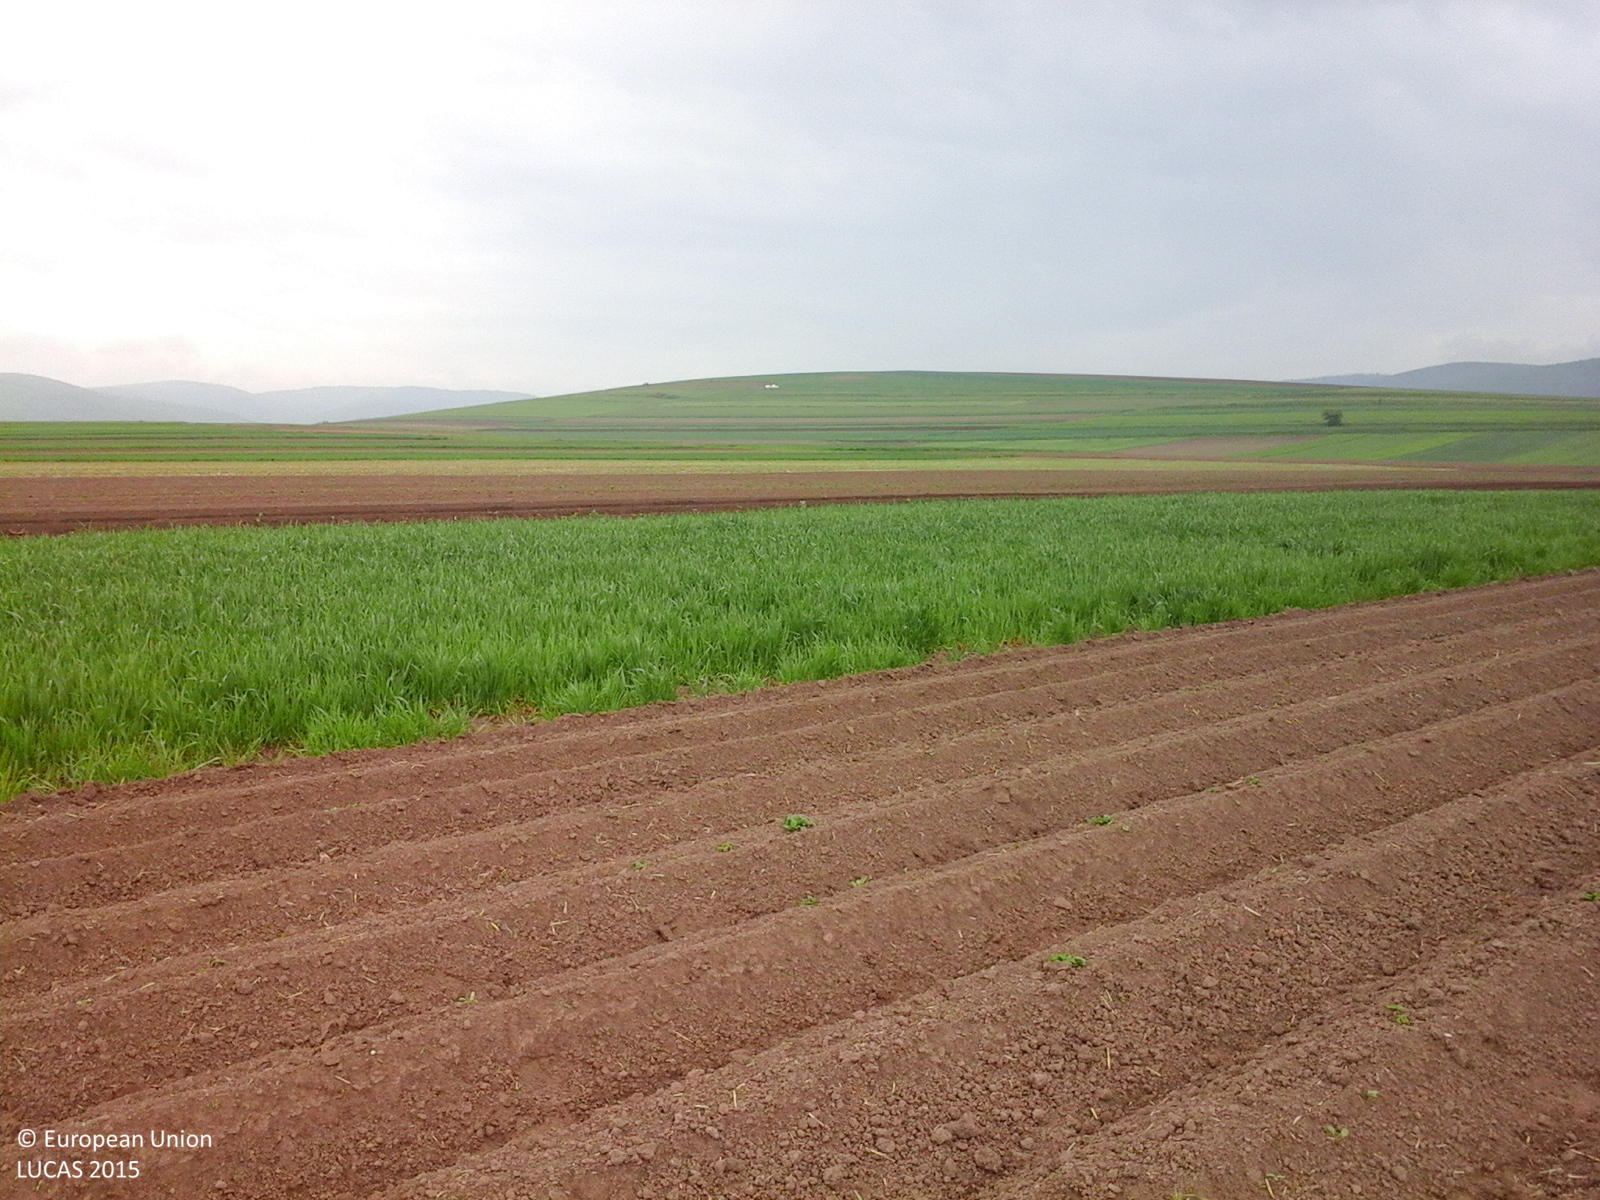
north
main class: Cropland
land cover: Potatoes
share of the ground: < 10 %
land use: Agriculture (excluding fallow land and kitchen gardens)
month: May
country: RO
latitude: 46.0423
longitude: 26.0784
